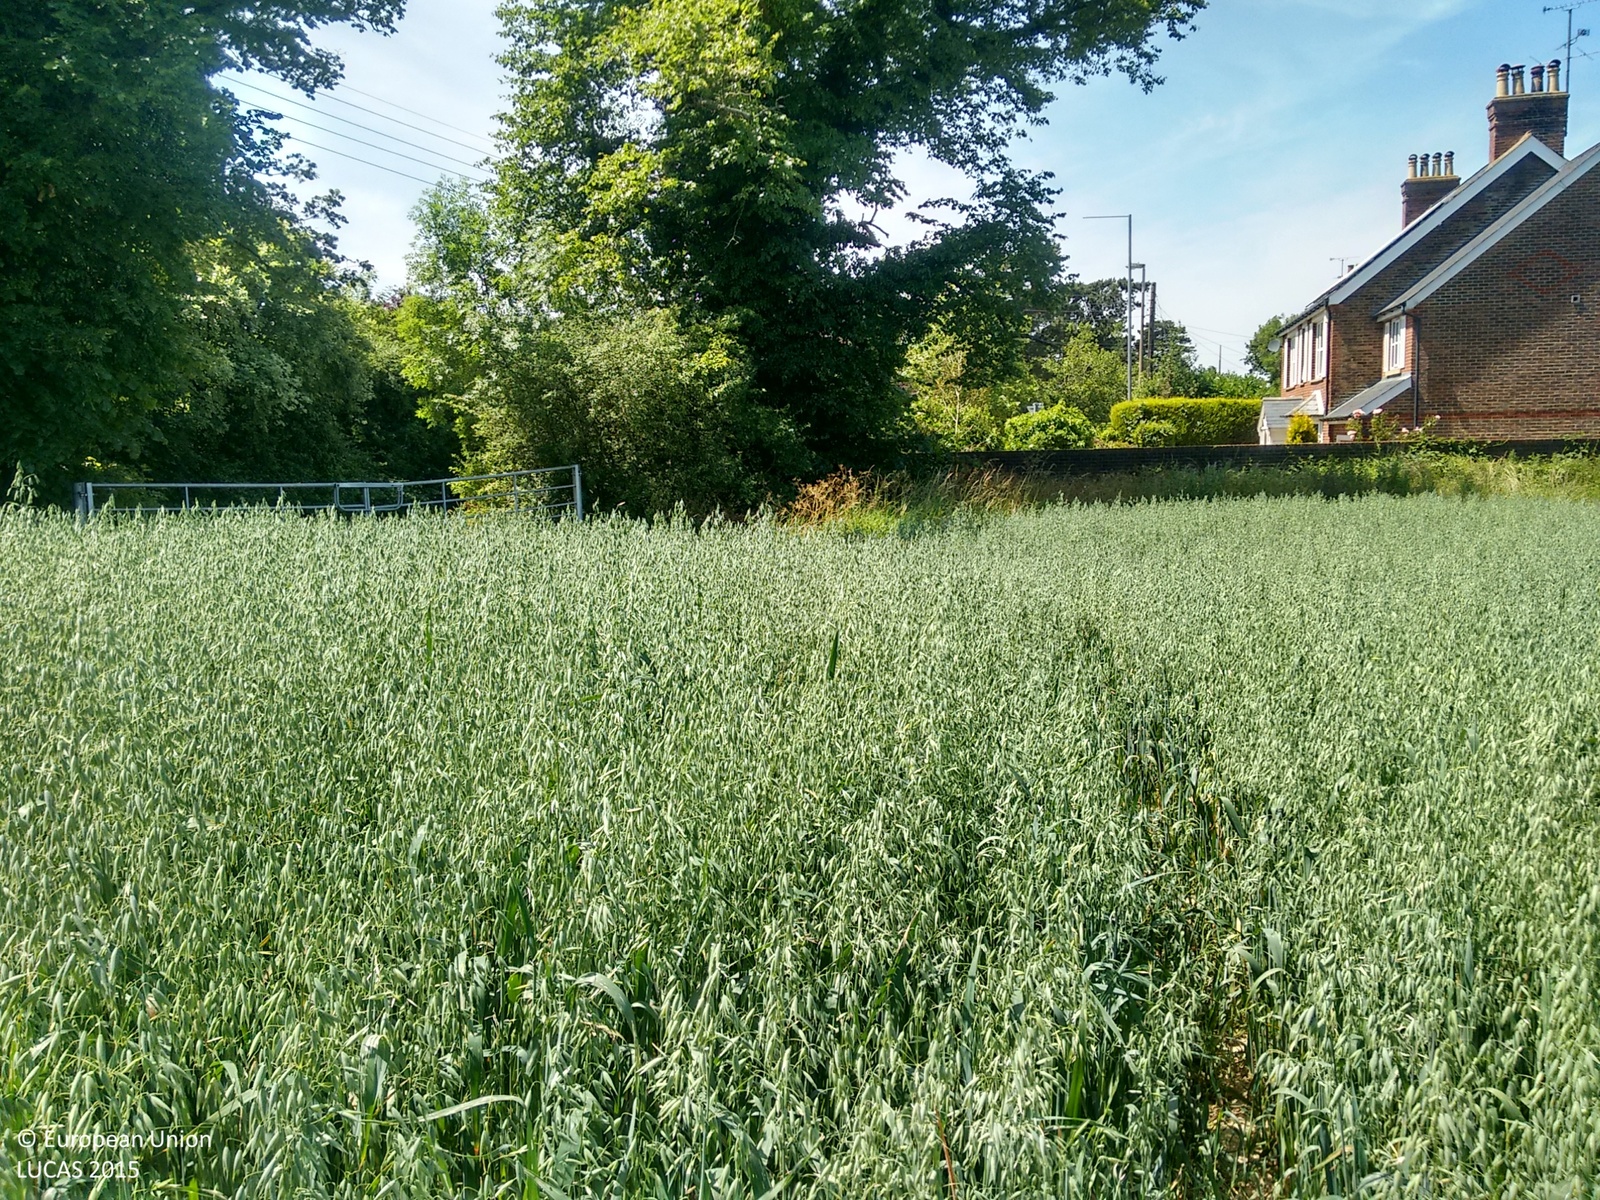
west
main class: Cropland
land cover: Oats
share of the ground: > 75 %
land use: Agriculture (excluding fallow land and kitchen gardens)
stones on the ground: 10 - 25 %
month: July
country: GB
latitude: 51.0713
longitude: -0.3551
